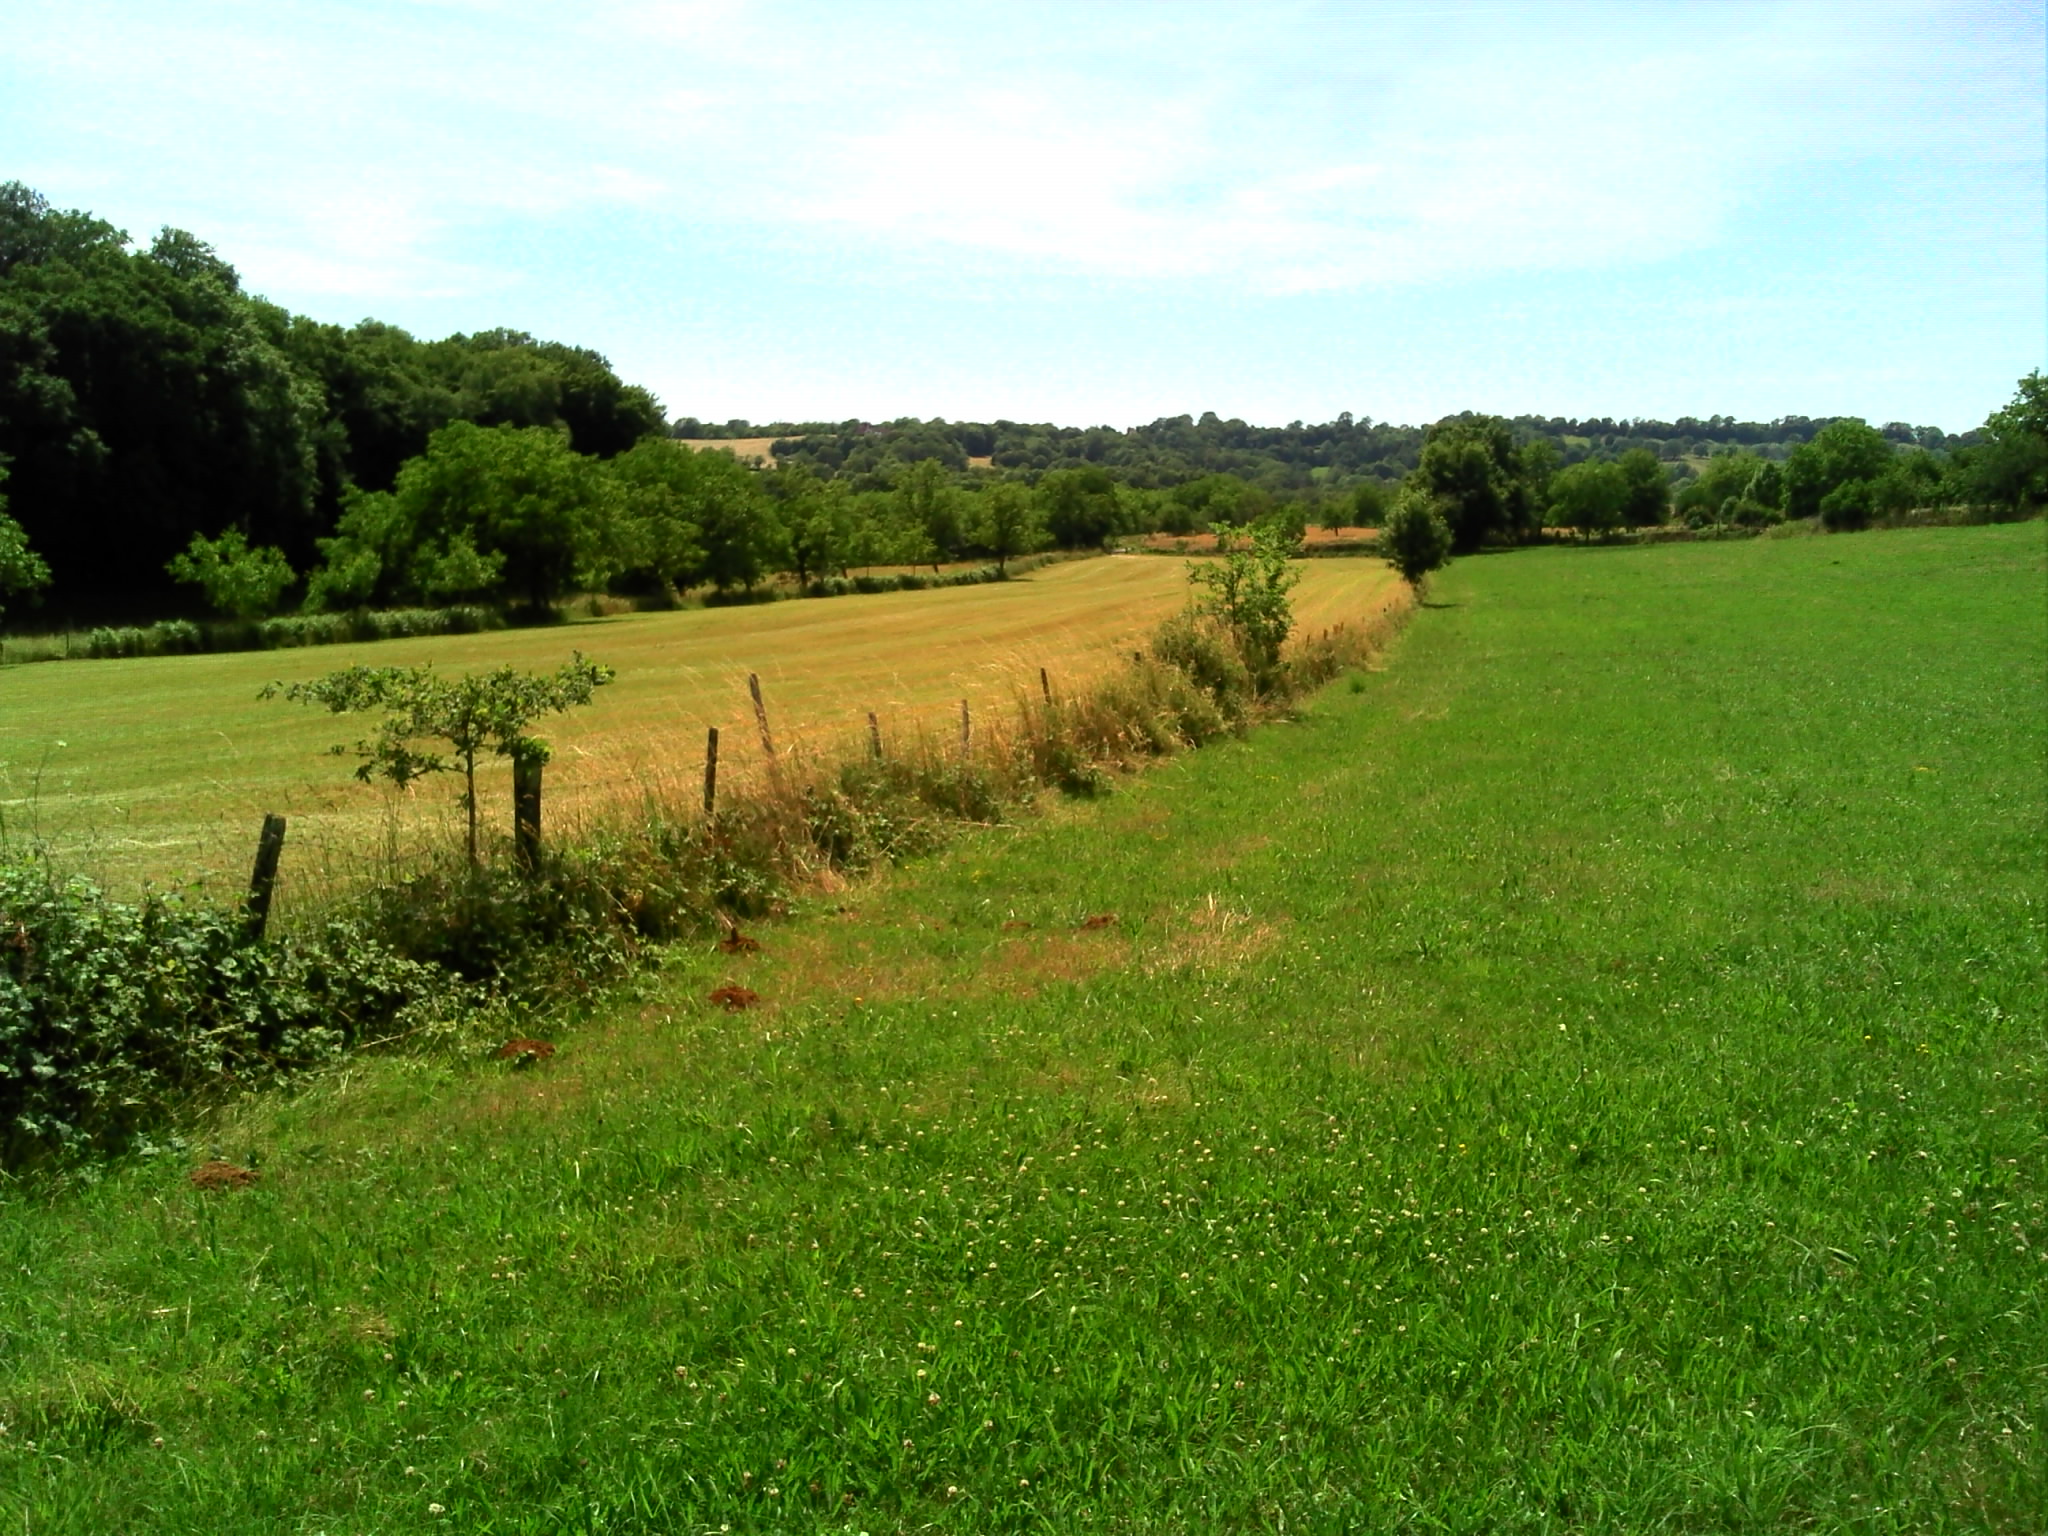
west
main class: Grassland
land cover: Grassland without tree/shrub cover
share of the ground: > 75 %
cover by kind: herbaceous plants 100 %
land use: Agriculture (excluding fallow land and kitchen gardens)
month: June
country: FR
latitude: 44.8201
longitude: 1.7652
